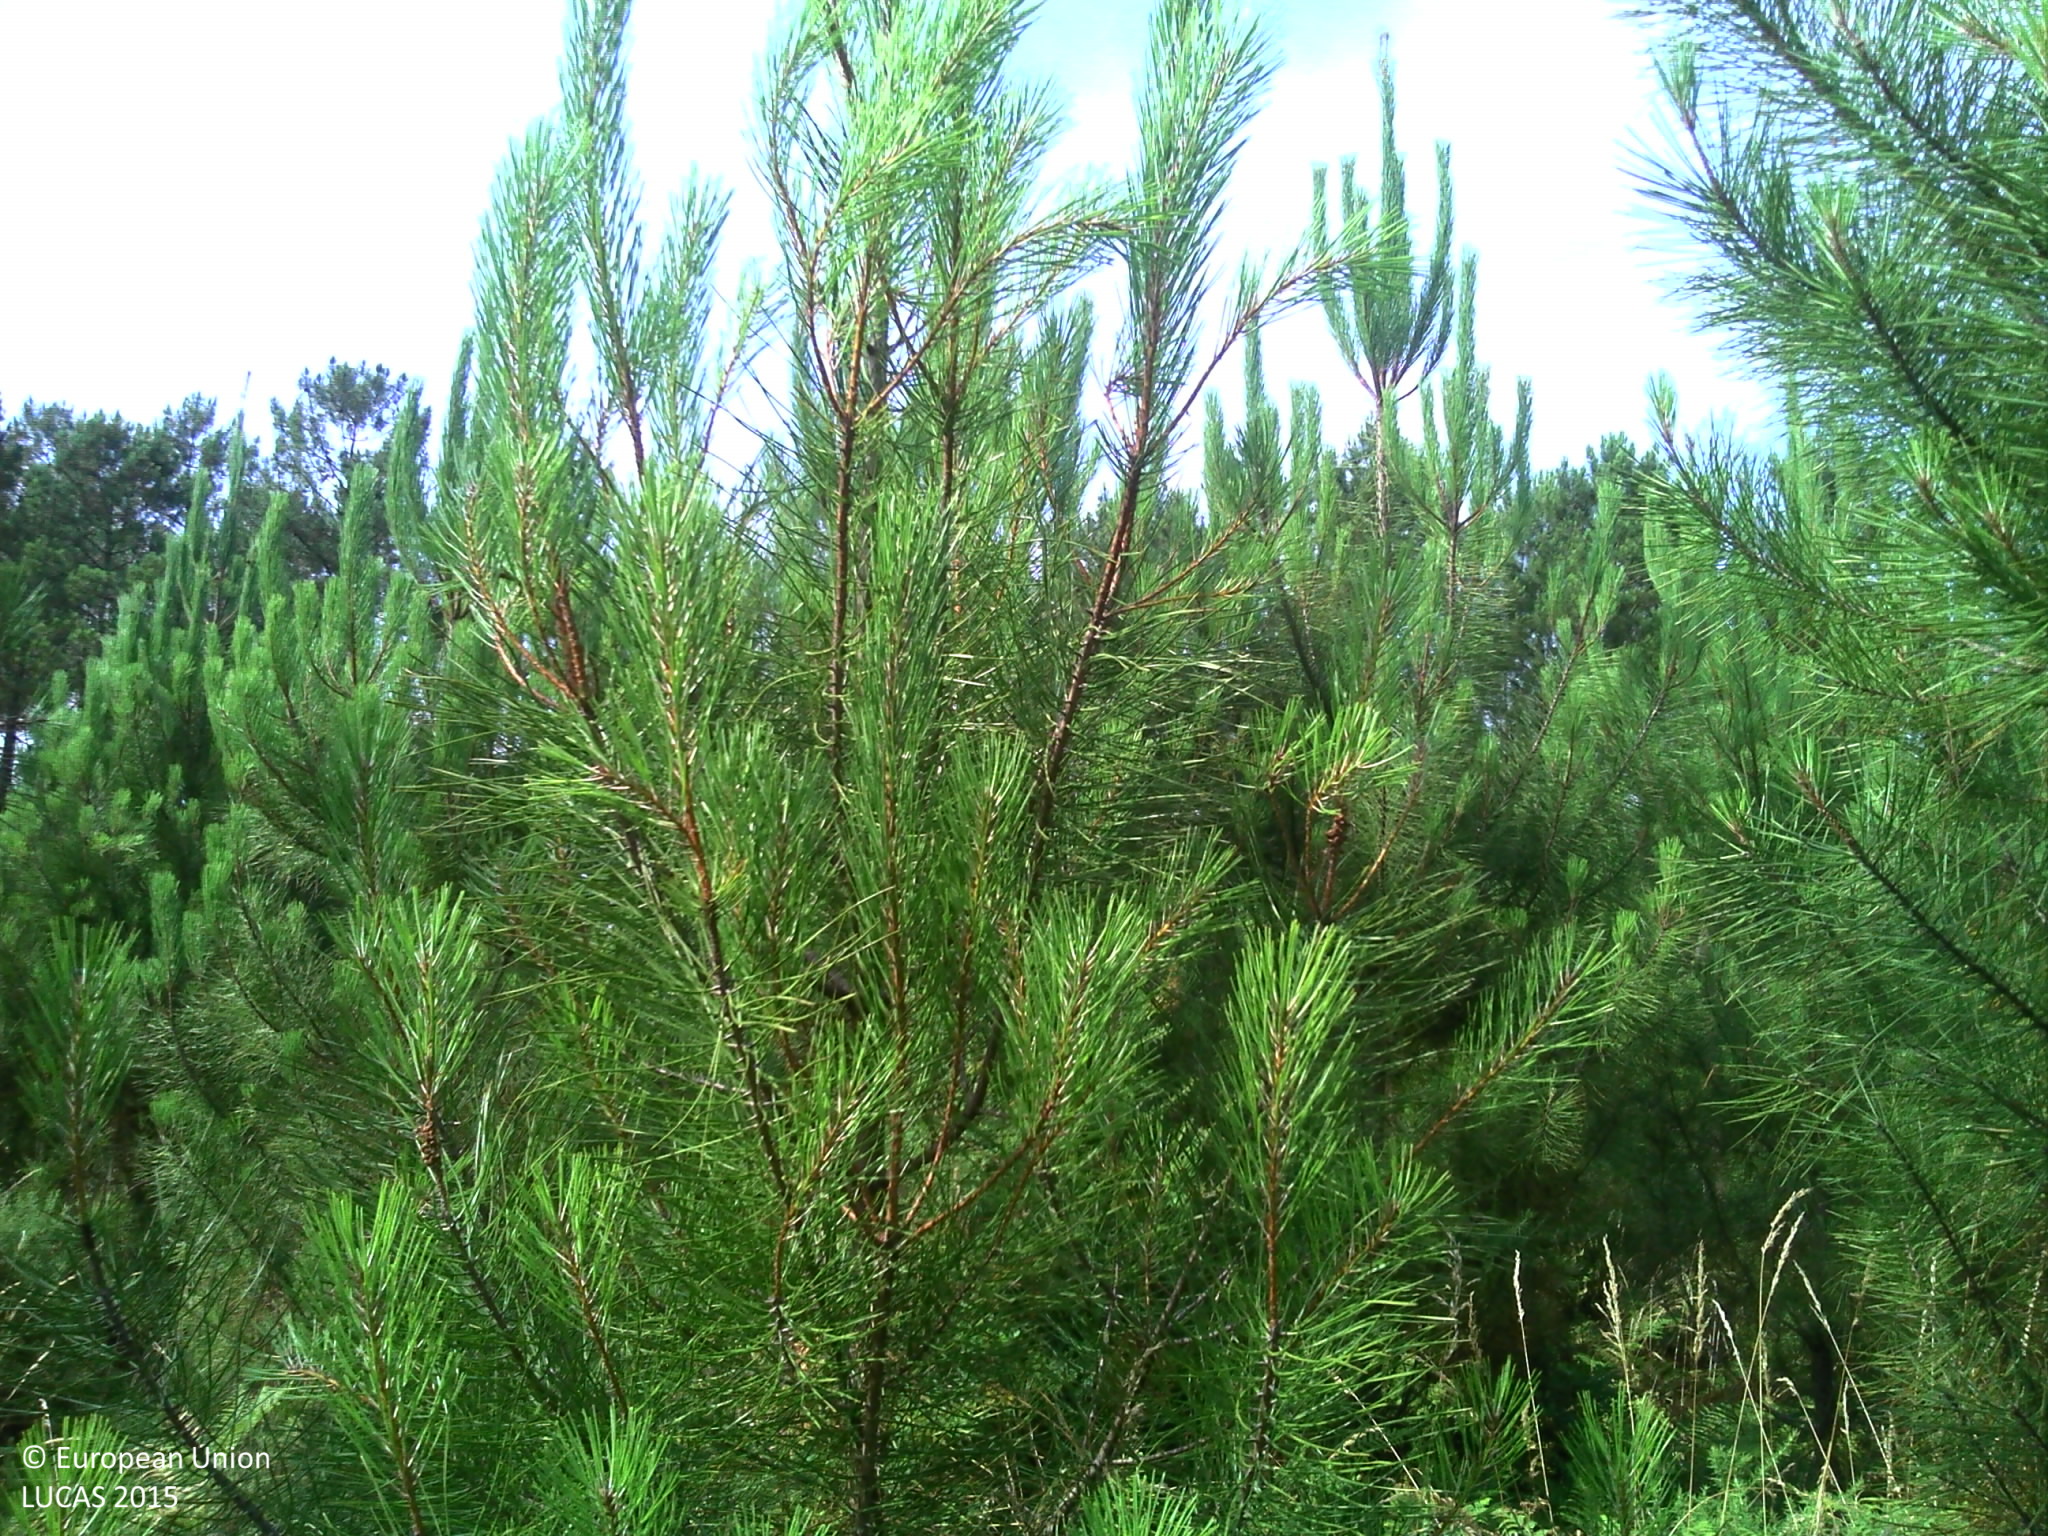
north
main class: Woodland
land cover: Pine dominated coniferous woodland
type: coniferous forest of the mediterranean region
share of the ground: > 75 %
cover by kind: coniferous forest trees 70 %, herbaceous plants 20 %, broadleaved forest trees 5 %, unconsolidated bare surface 5 %
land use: Forestry
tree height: < 5 m
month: July
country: FR
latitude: 43.7719
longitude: -1.2613
